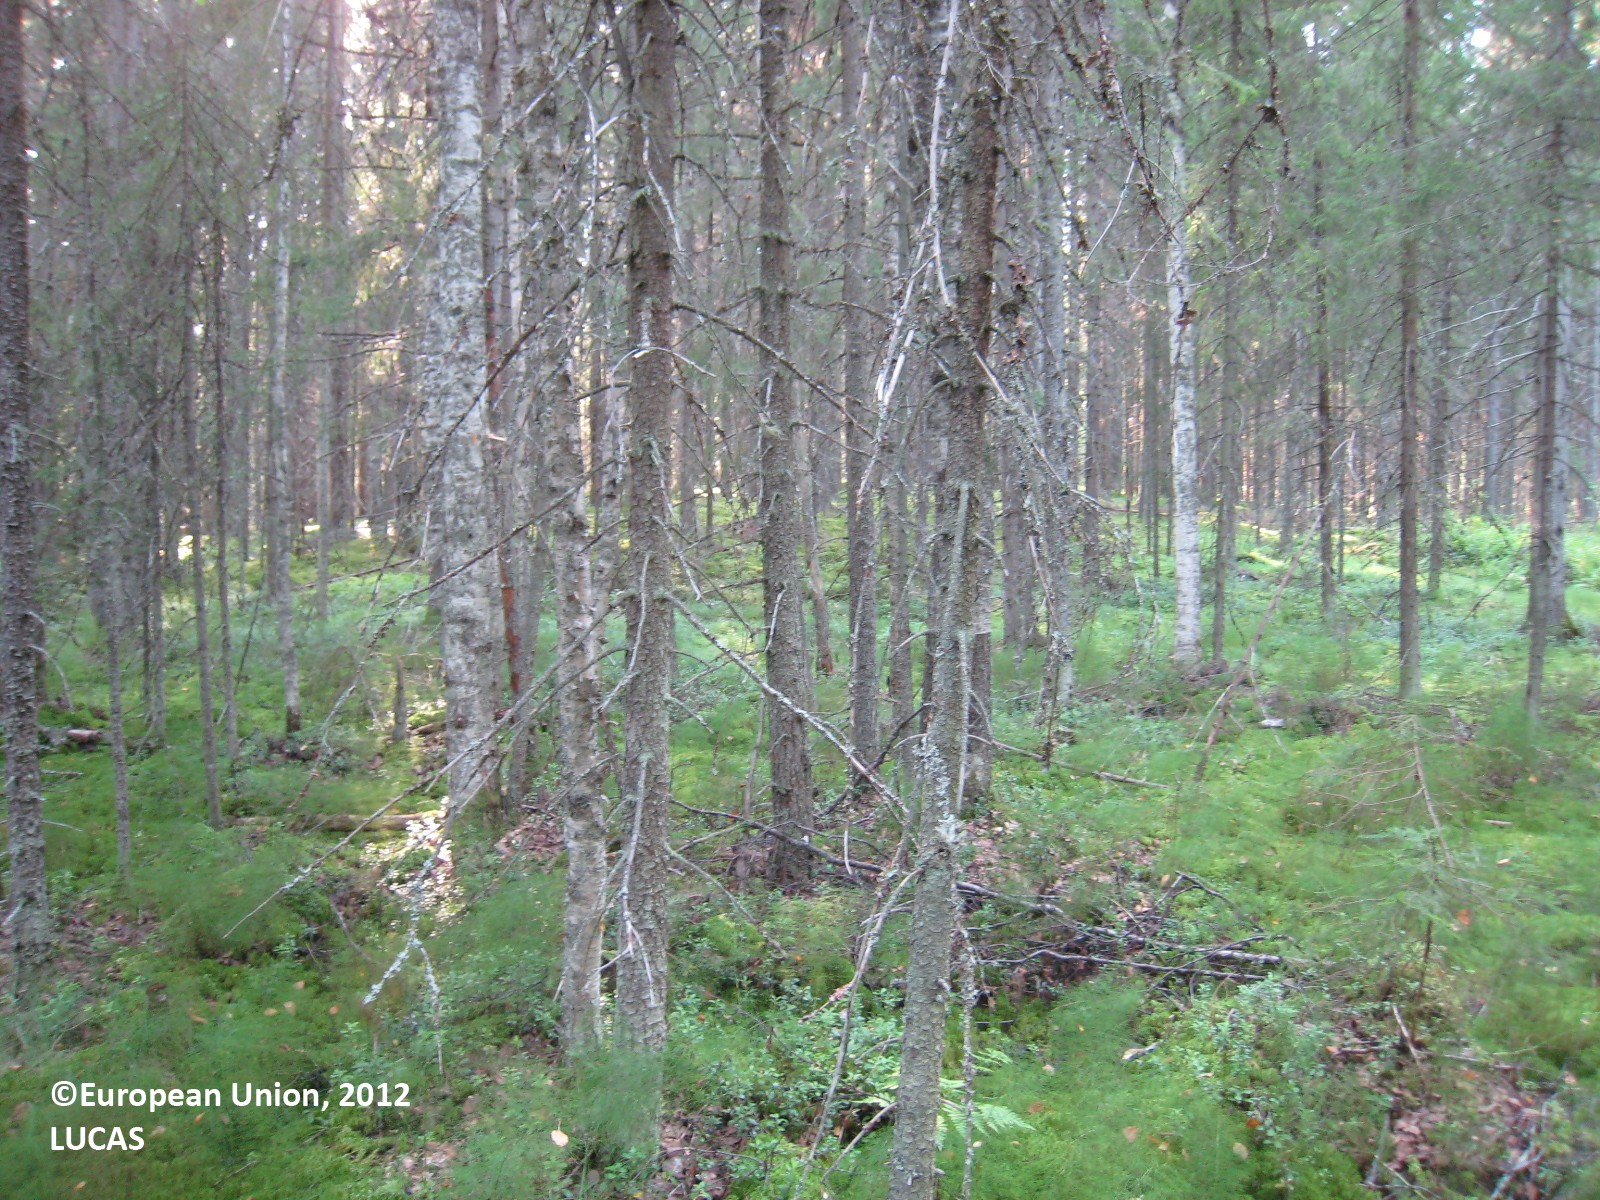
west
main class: Woodland
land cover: Spruce dominated mixed woodland
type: mire and swamp forests
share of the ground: > 75 %
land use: Forestry
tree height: > 5 m
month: July
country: FI
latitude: 62.5892
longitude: 27.3946
